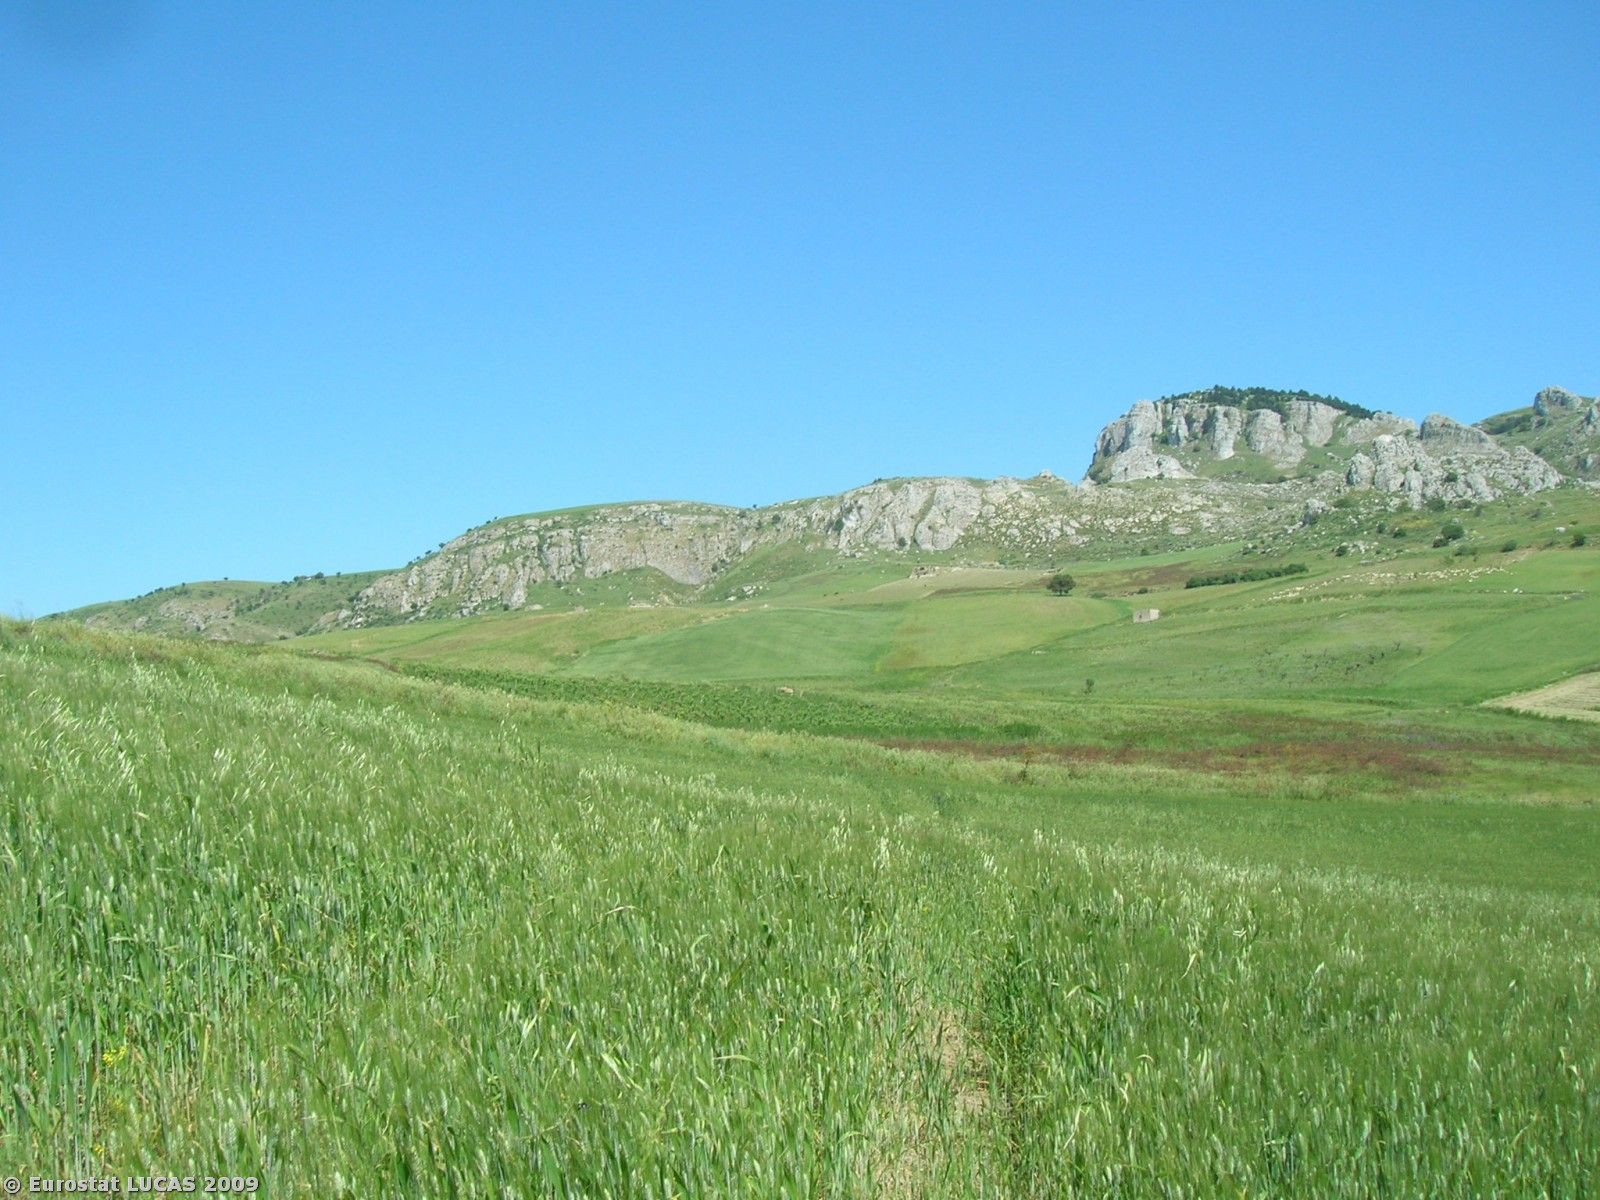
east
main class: Cropland
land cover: Durum wheat
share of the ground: > 75 %
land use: Agriculture (excluding fallow land and kitchen gardens)
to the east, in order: Durum wheat; Other leguminous and mixtures for fodder; Grass margins; Paved roads, cycling and walking lanes; Grass margins; Other leguminous and mixtures for fodder
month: May
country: IT
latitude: 37.6964
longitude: 13.1182
